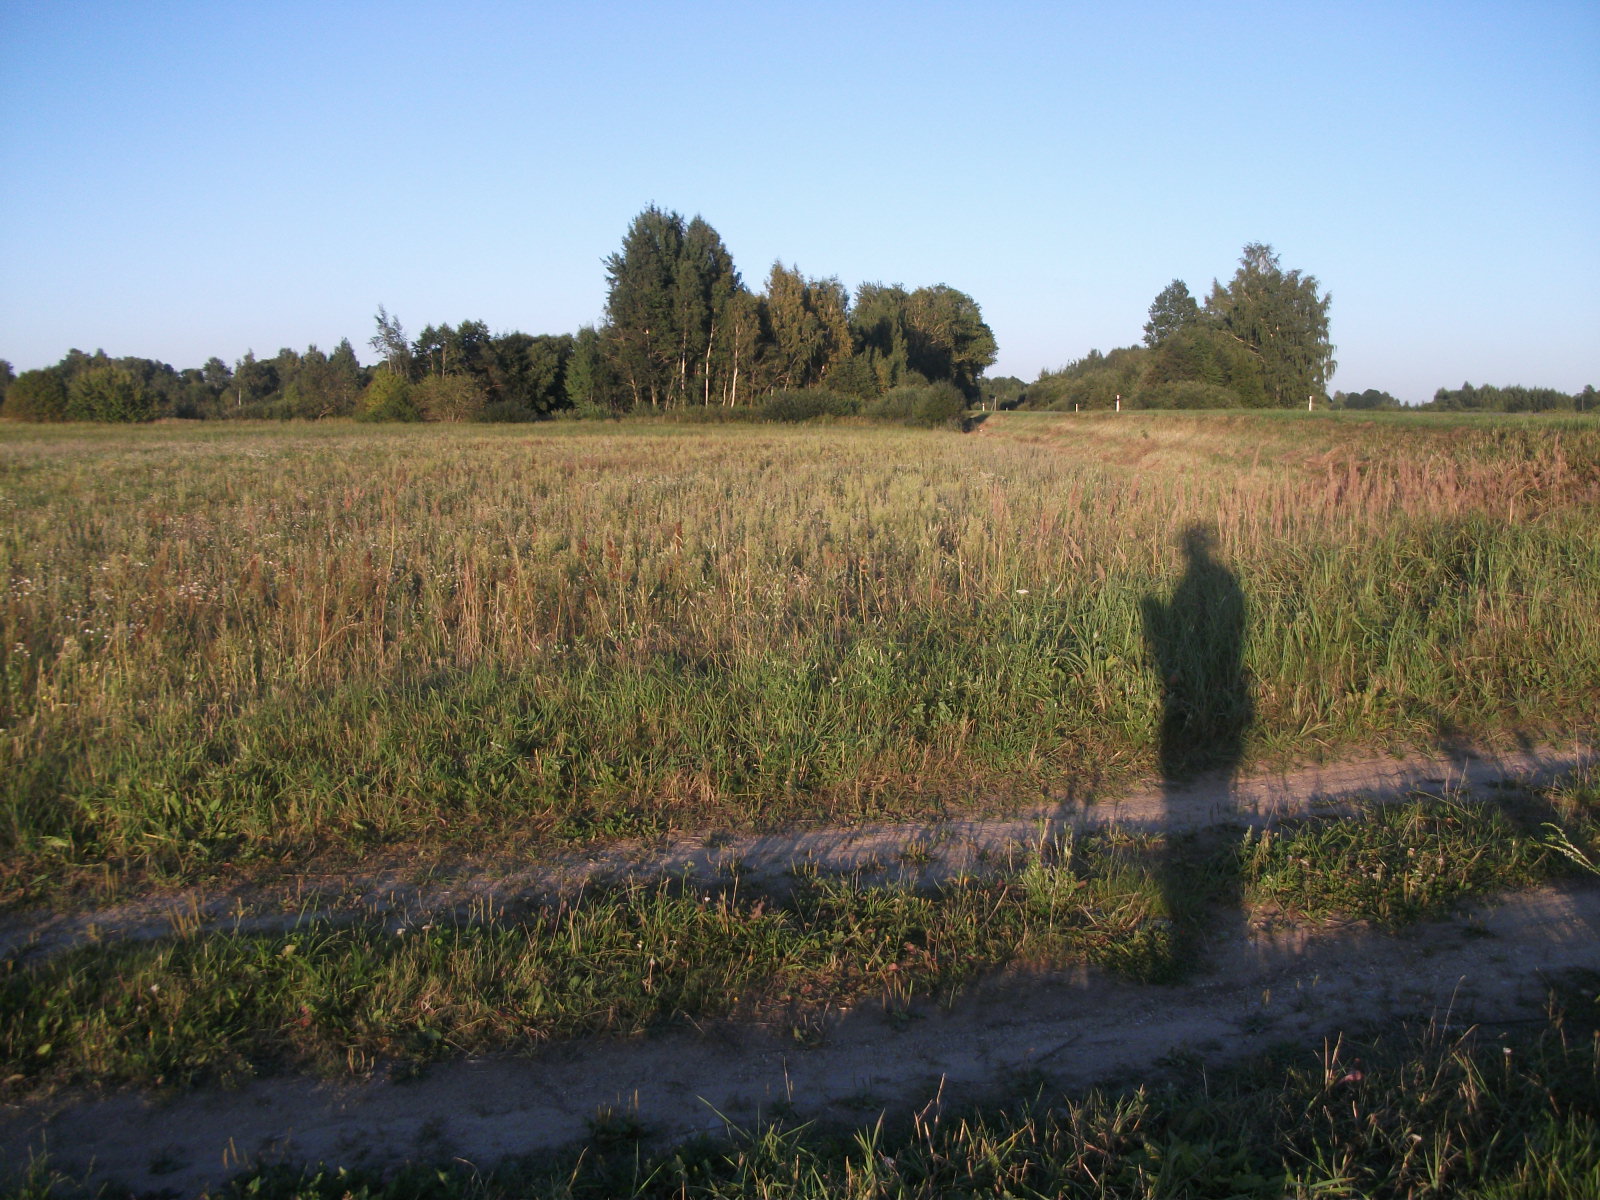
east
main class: Grassland
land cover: Grassland without tree/shrub cover
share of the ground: > 75 %
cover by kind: herbaceous plants 100 %
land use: Agriculture (excluding fallow land and kitchen gardens)
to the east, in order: Shruby margins; Grassland without tree/shrub cover; Tracks; Grassland without tree/shrub cover; Spontaneously vegetated surfaces; Ditches and canals; Abandoned hedges; Tracks; Broadleaved woodland; Grassland without tree/shrub cover
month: August
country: LV
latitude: 56.3479
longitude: 26.3073
